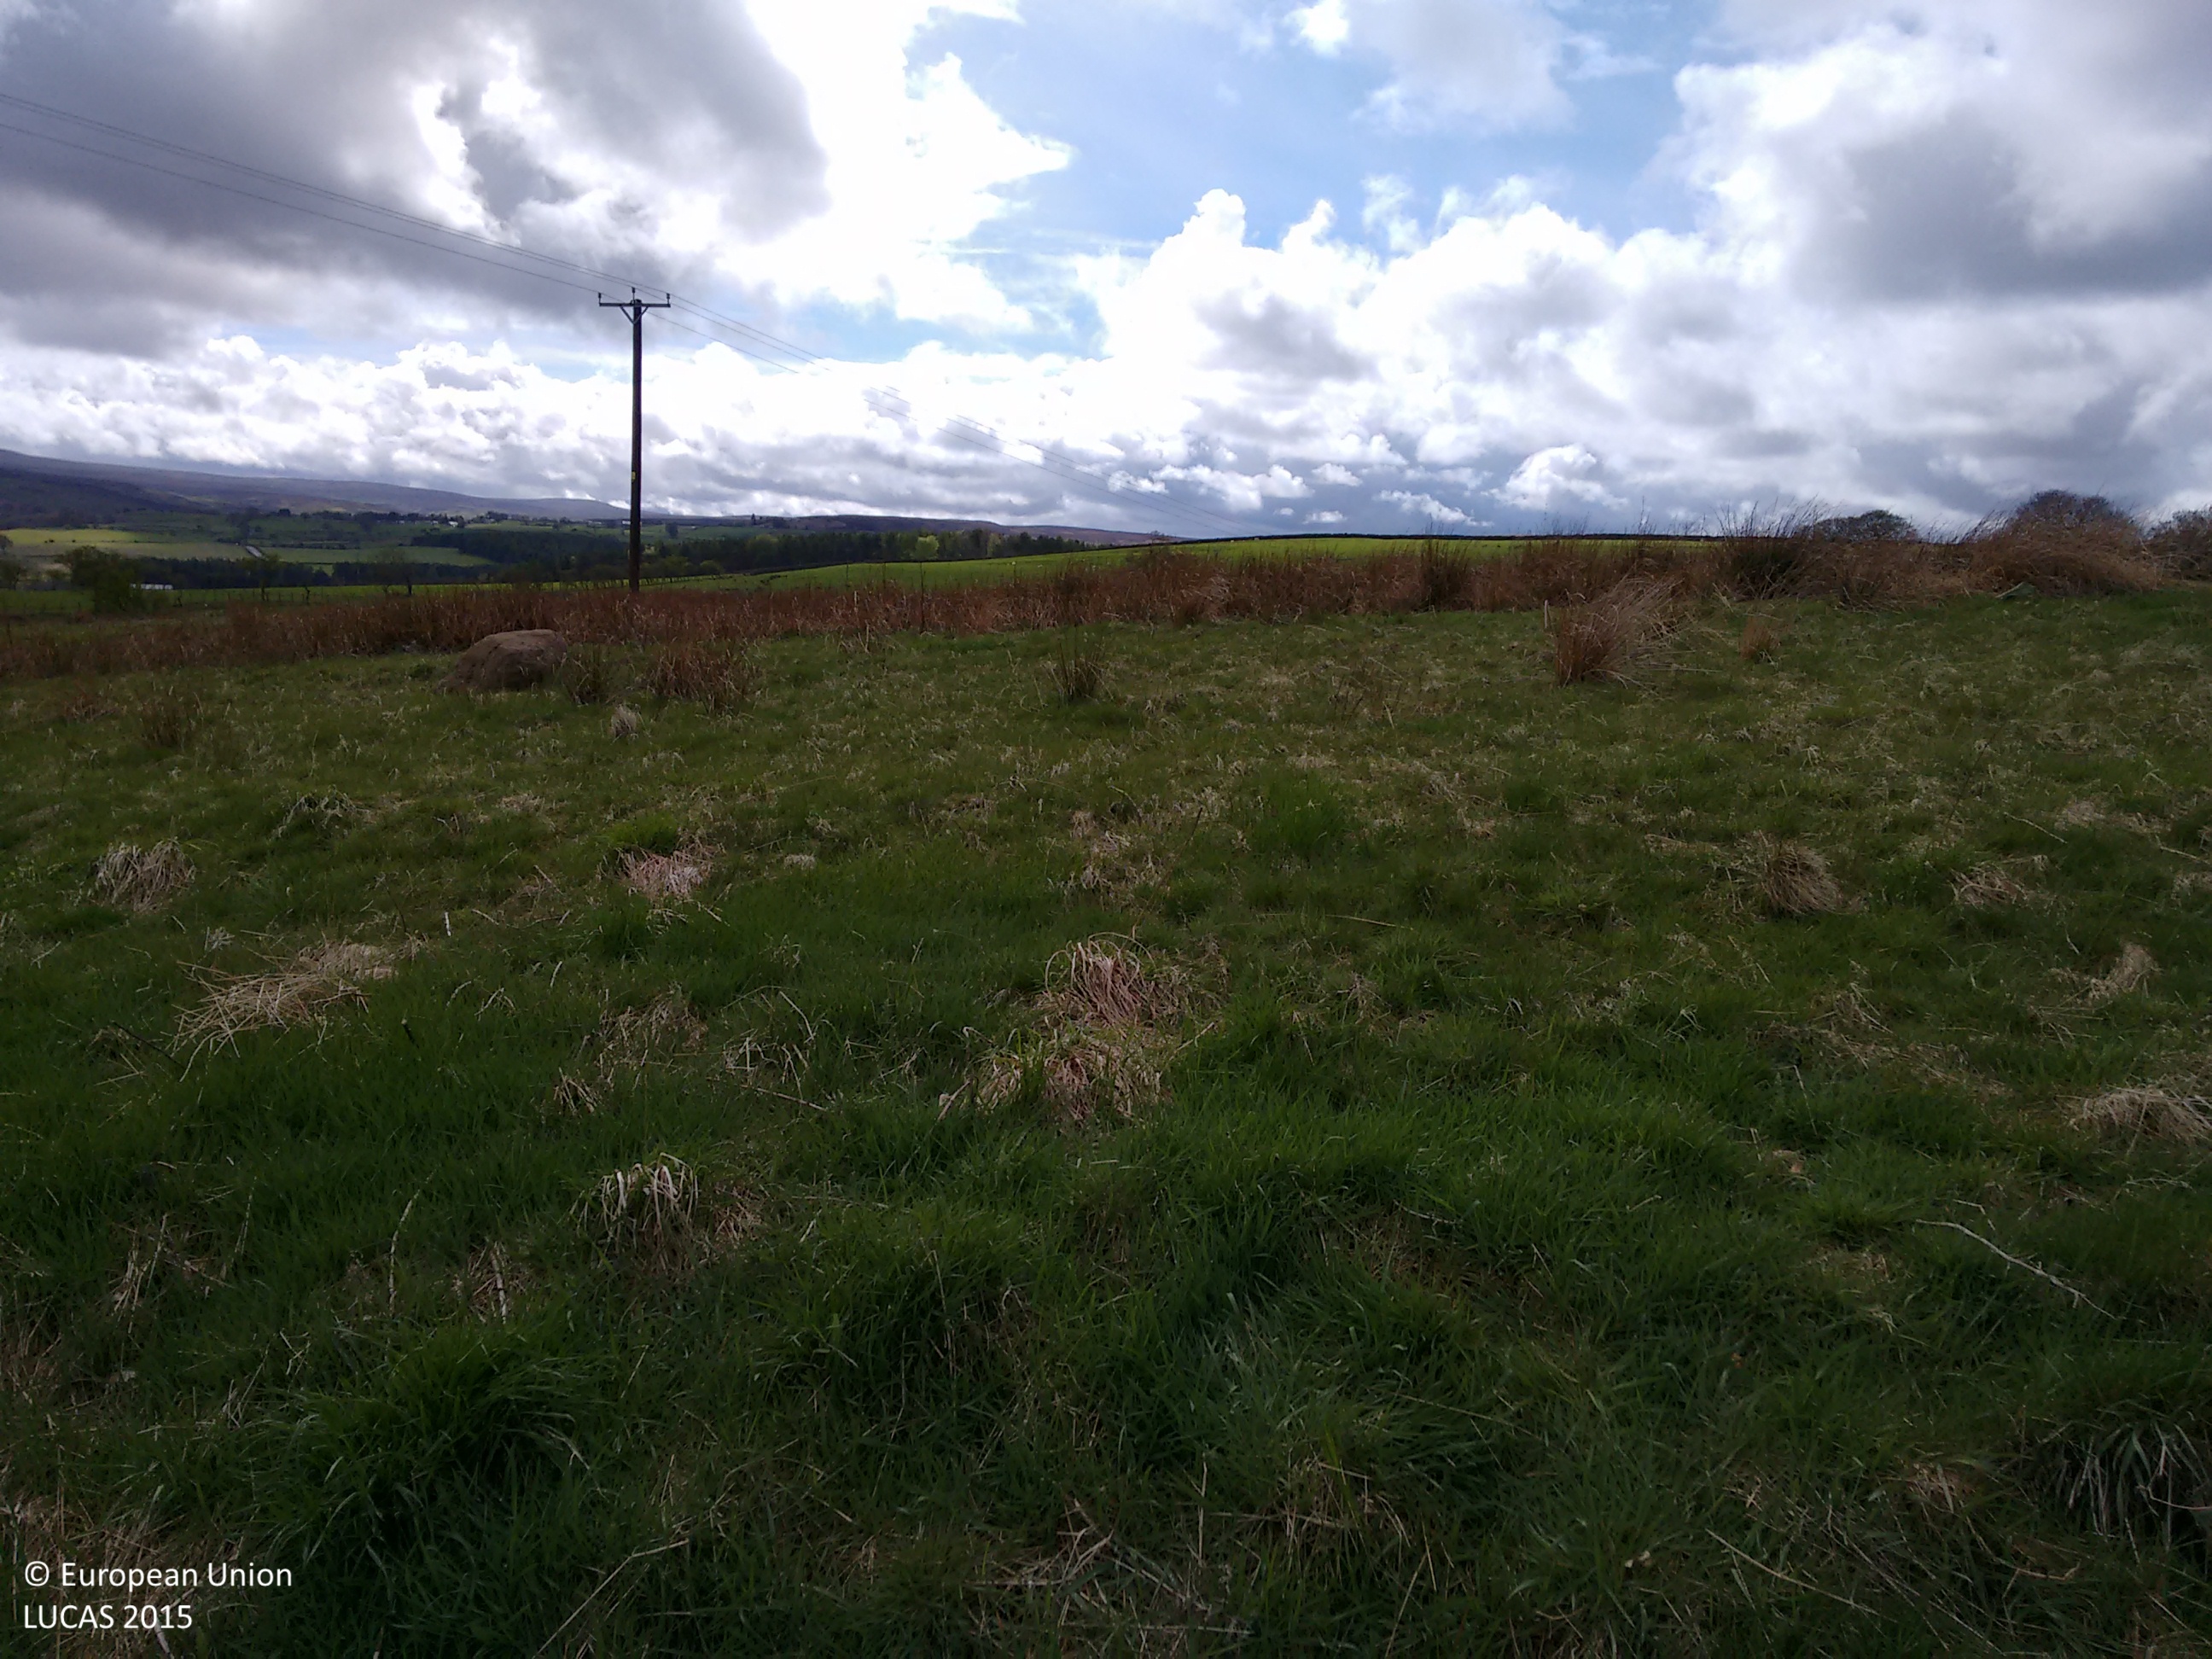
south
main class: Grassland
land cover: Grassland with sparse tree/shrub cover
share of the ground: > 75 %
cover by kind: herbaceous plants 95 %, broadleaved forest trees 5 %
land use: Semi-natural and natural areas not in use
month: May
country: GB
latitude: 54.8636
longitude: -1.9417
